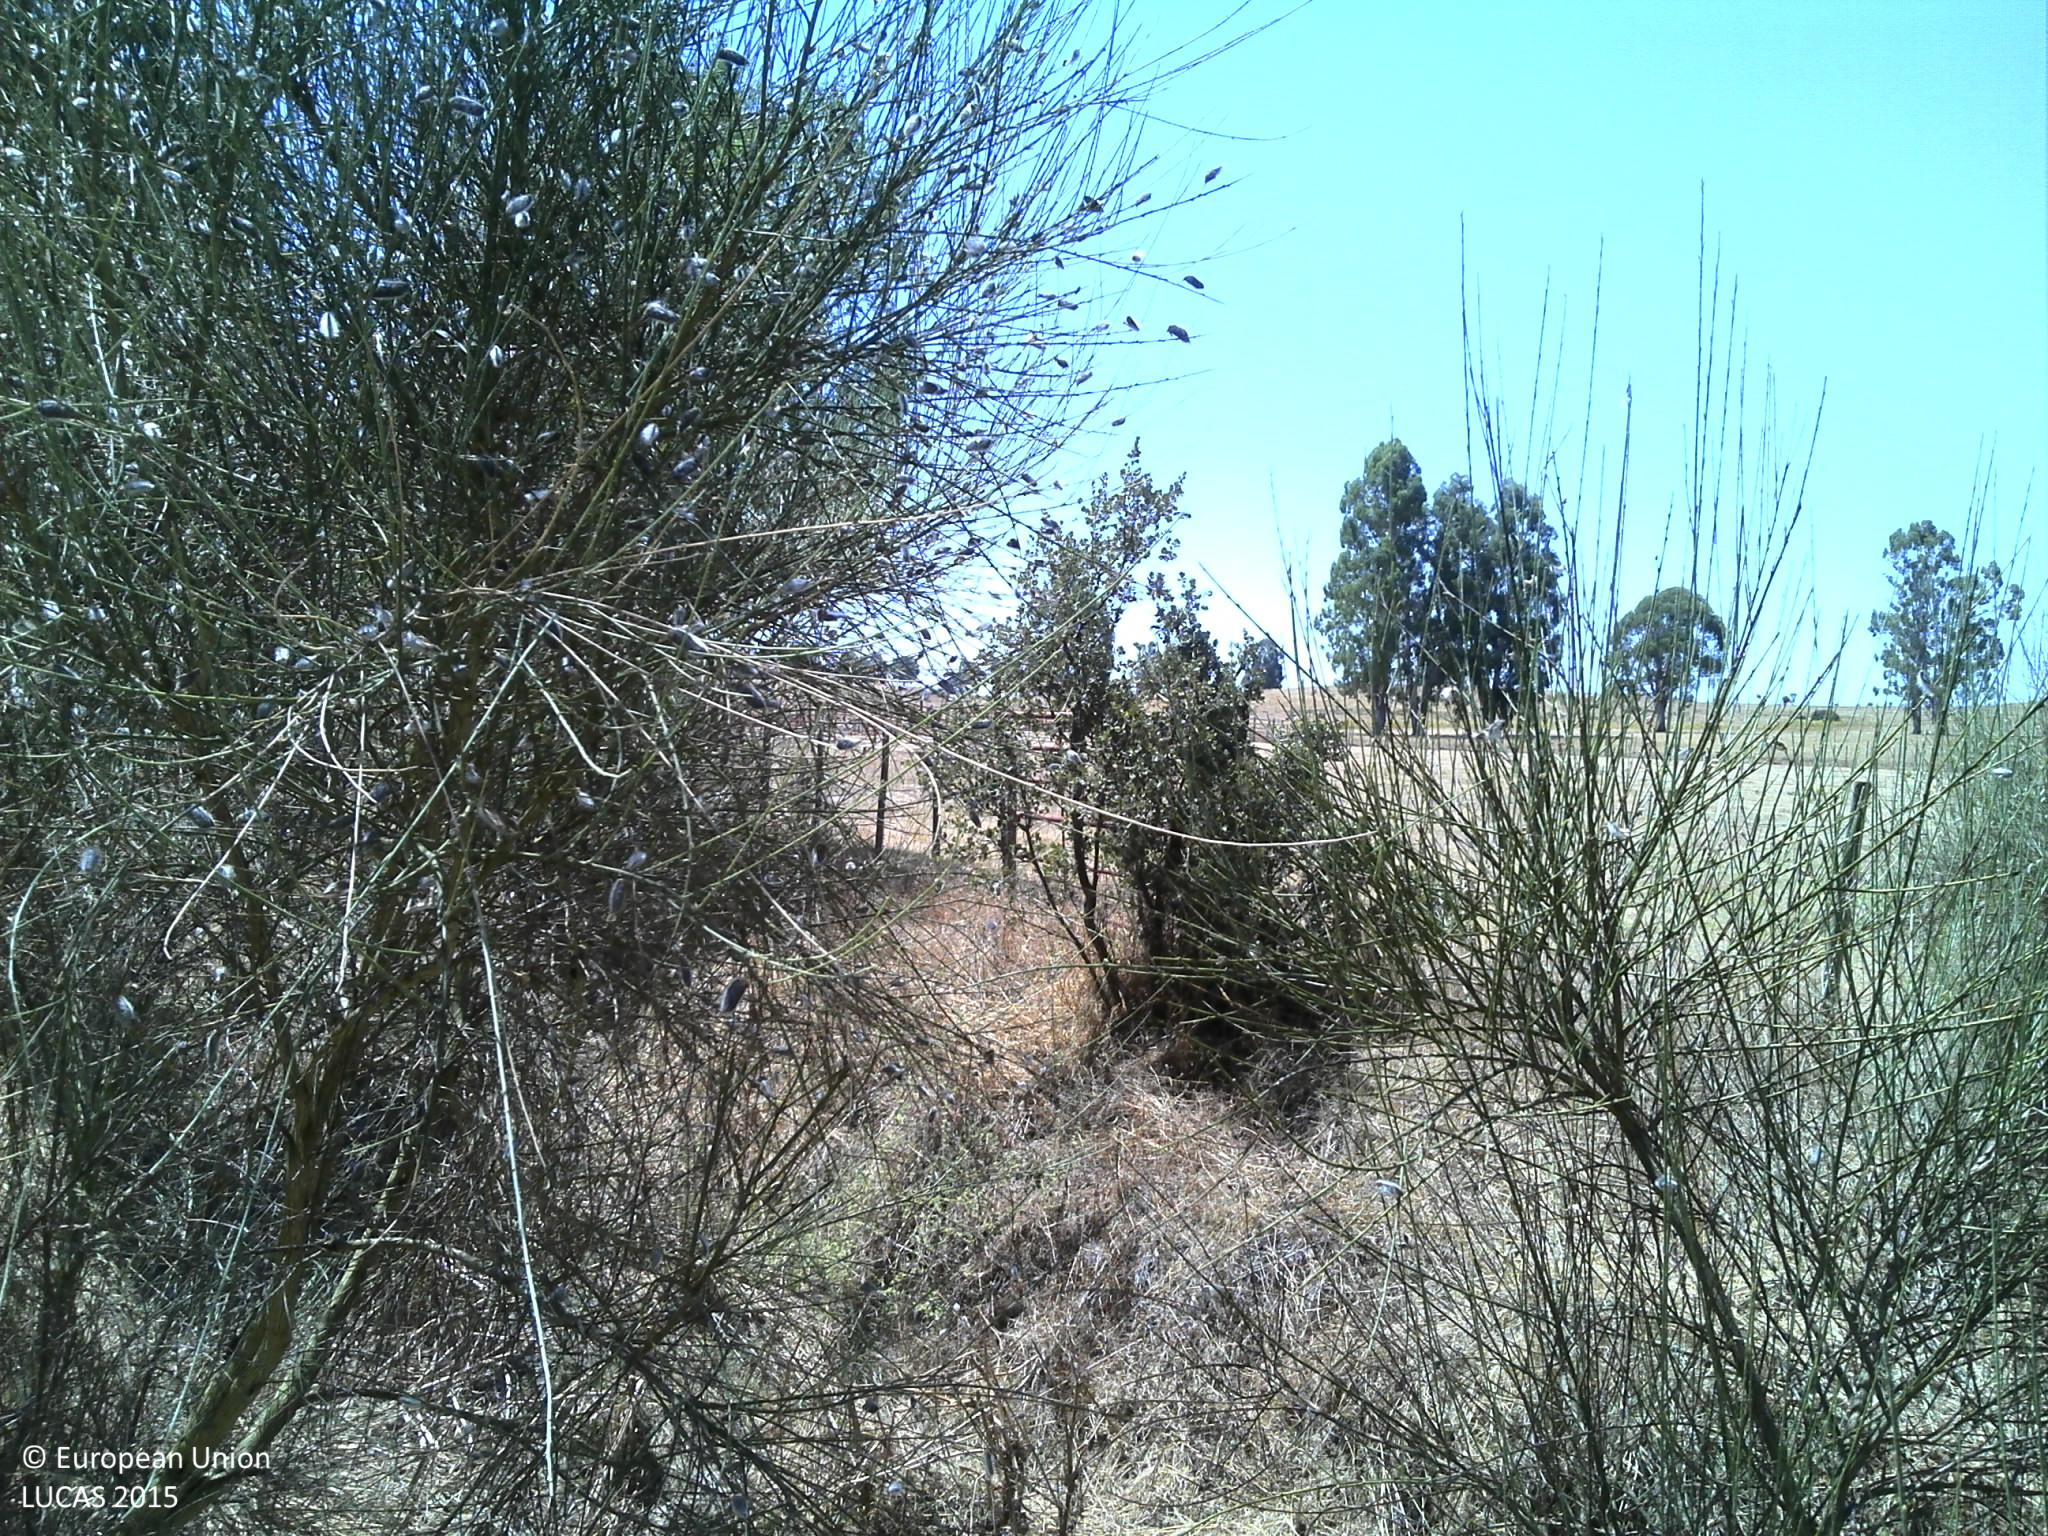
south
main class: Woodland
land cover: Broadleaved woodland
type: broadleaved evergreen forest
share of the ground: 25 - 50 %
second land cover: Grassland without tree/shrub cover
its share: 25 - 50 %
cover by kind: unconsolidated bare surface 40 %, broadleaved forest trees 30 %, herbaceous plants 25 %, shrubs 5 %
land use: Forestry
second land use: Agriculture (excluding fallow land and kitchen gardens)
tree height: > 5 m
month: July
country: PT
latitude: 39.3592
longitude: -7.7250
